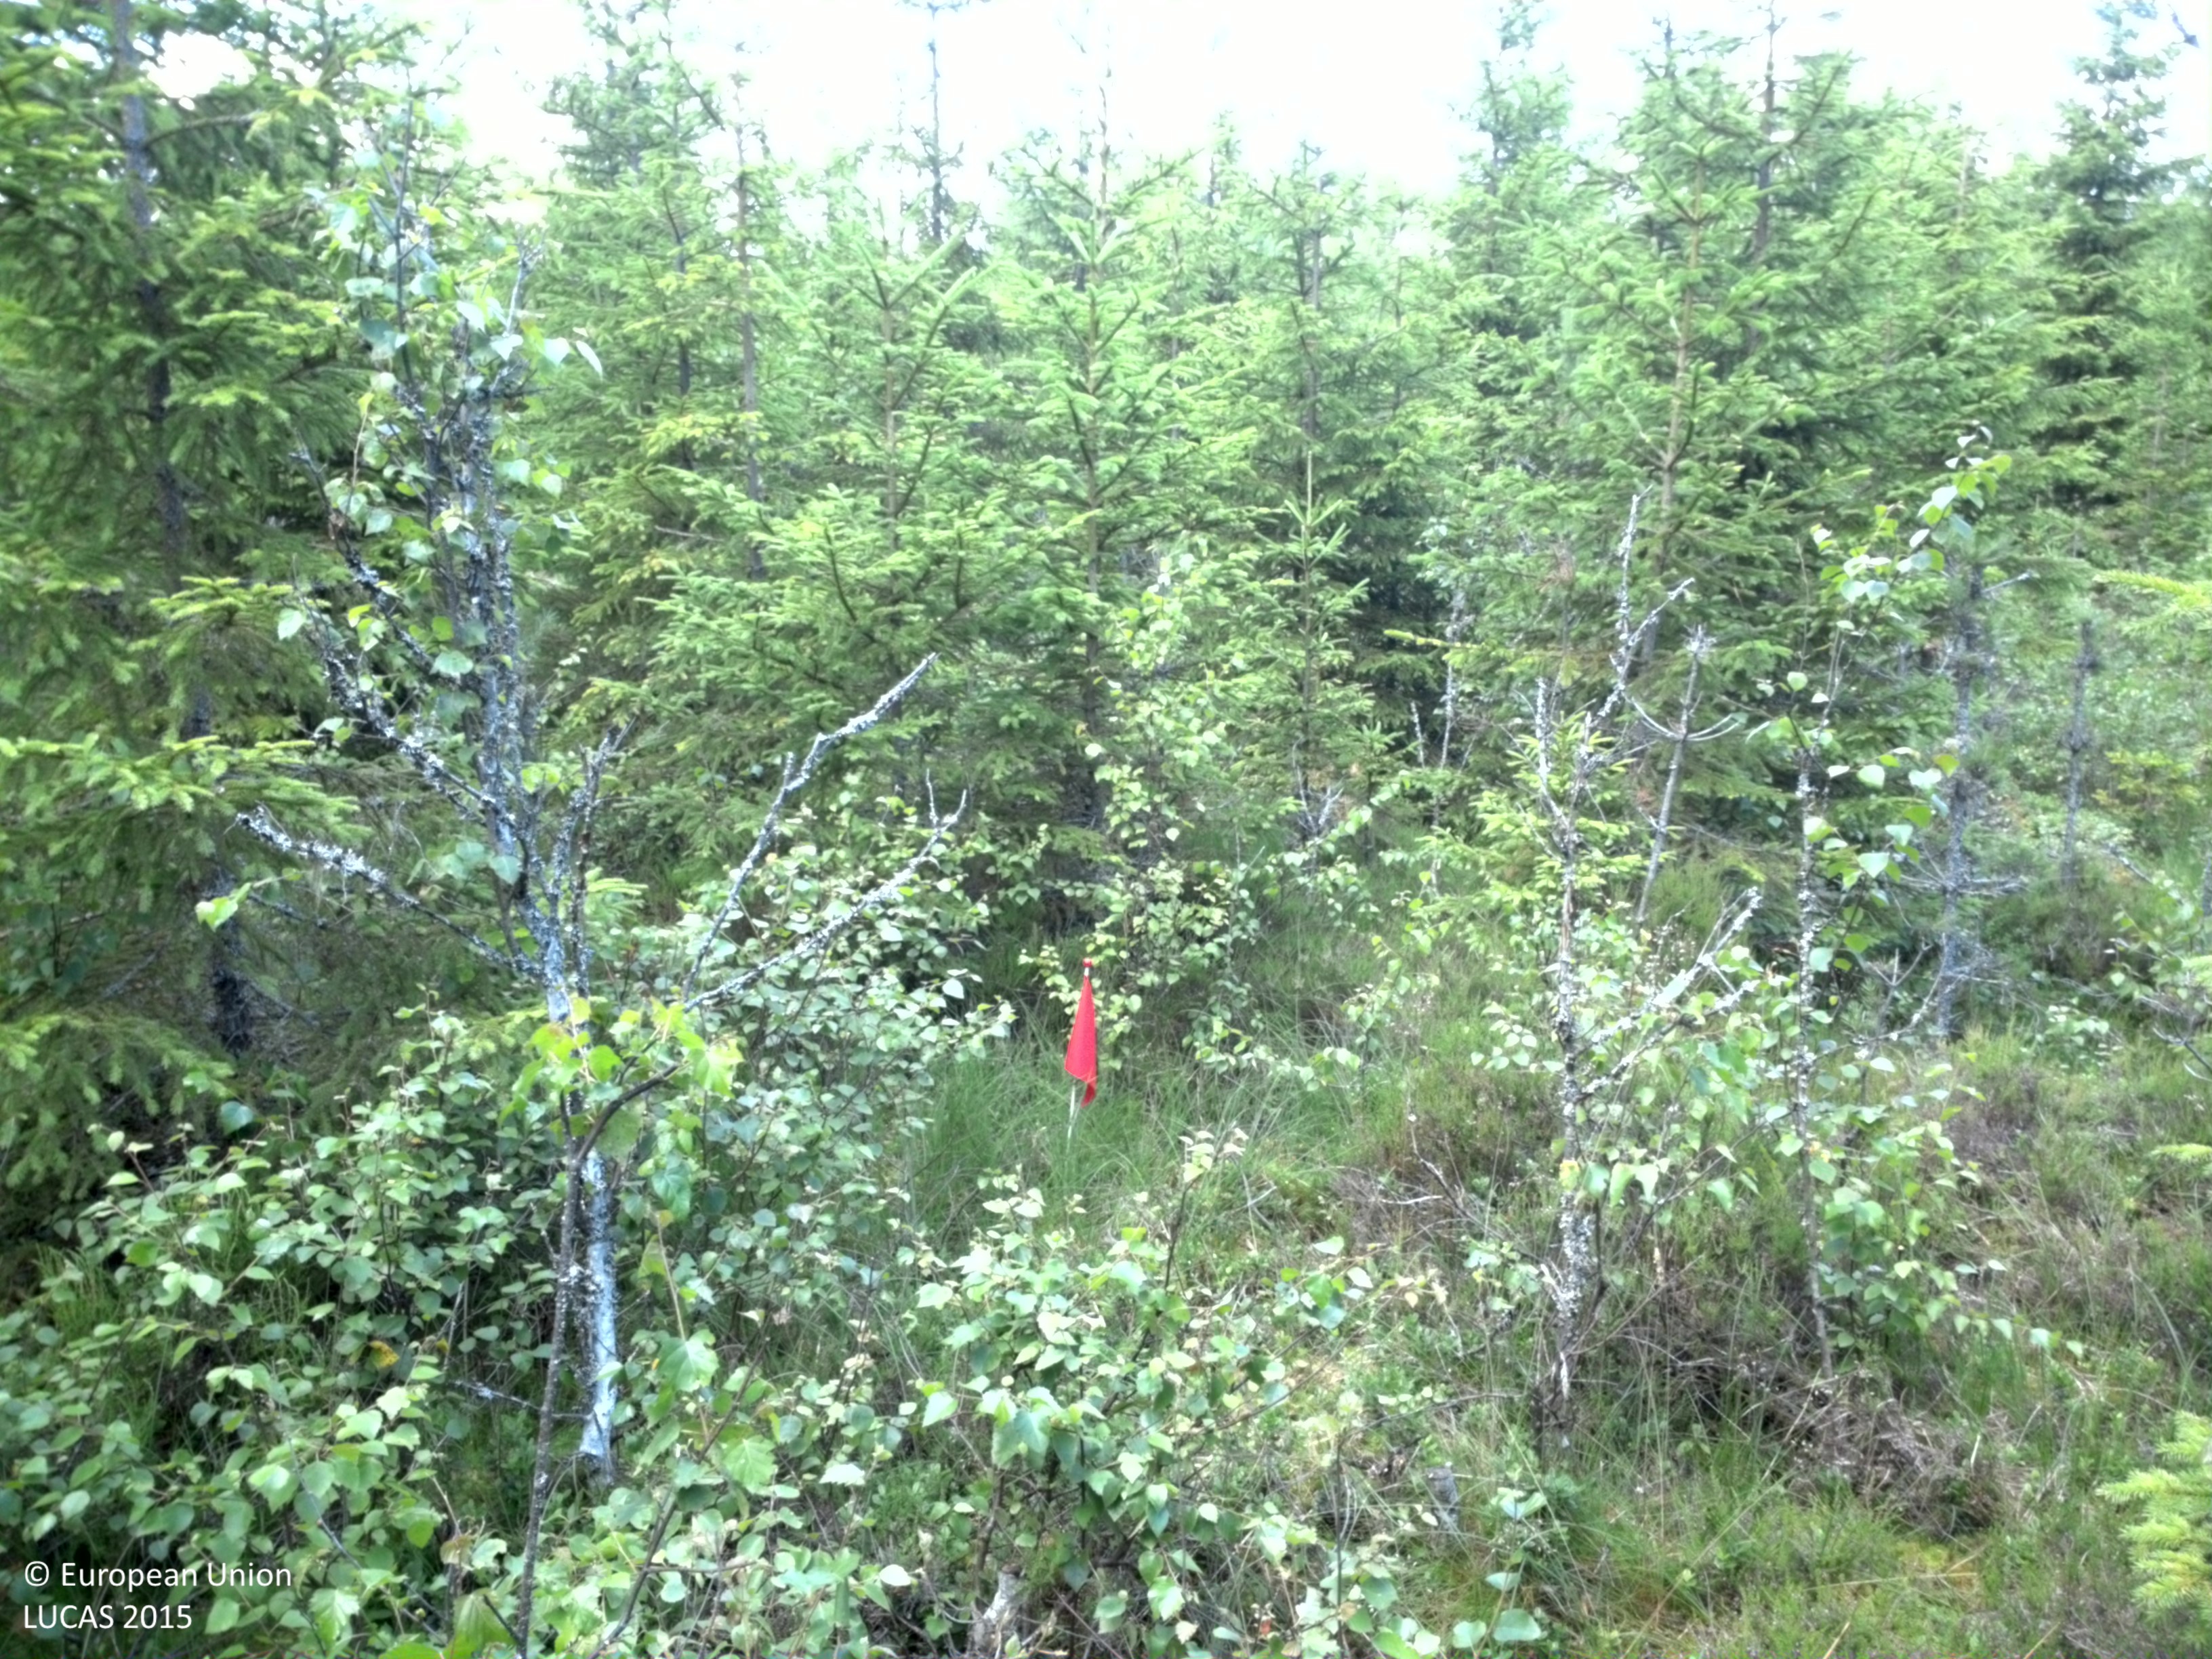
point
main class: Woodland
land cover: Spruce dominated mixed woodland
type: boreal forest
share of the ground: 50 - 75 %
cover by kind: coniferous forest trees 40 %, broadleaved forest trees 35 %, shrubs 20 %, lichens and mosses 5 %
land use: Forestry
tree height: < 5 m
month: July
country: SE
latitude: 58.5817
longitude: 14.3447
